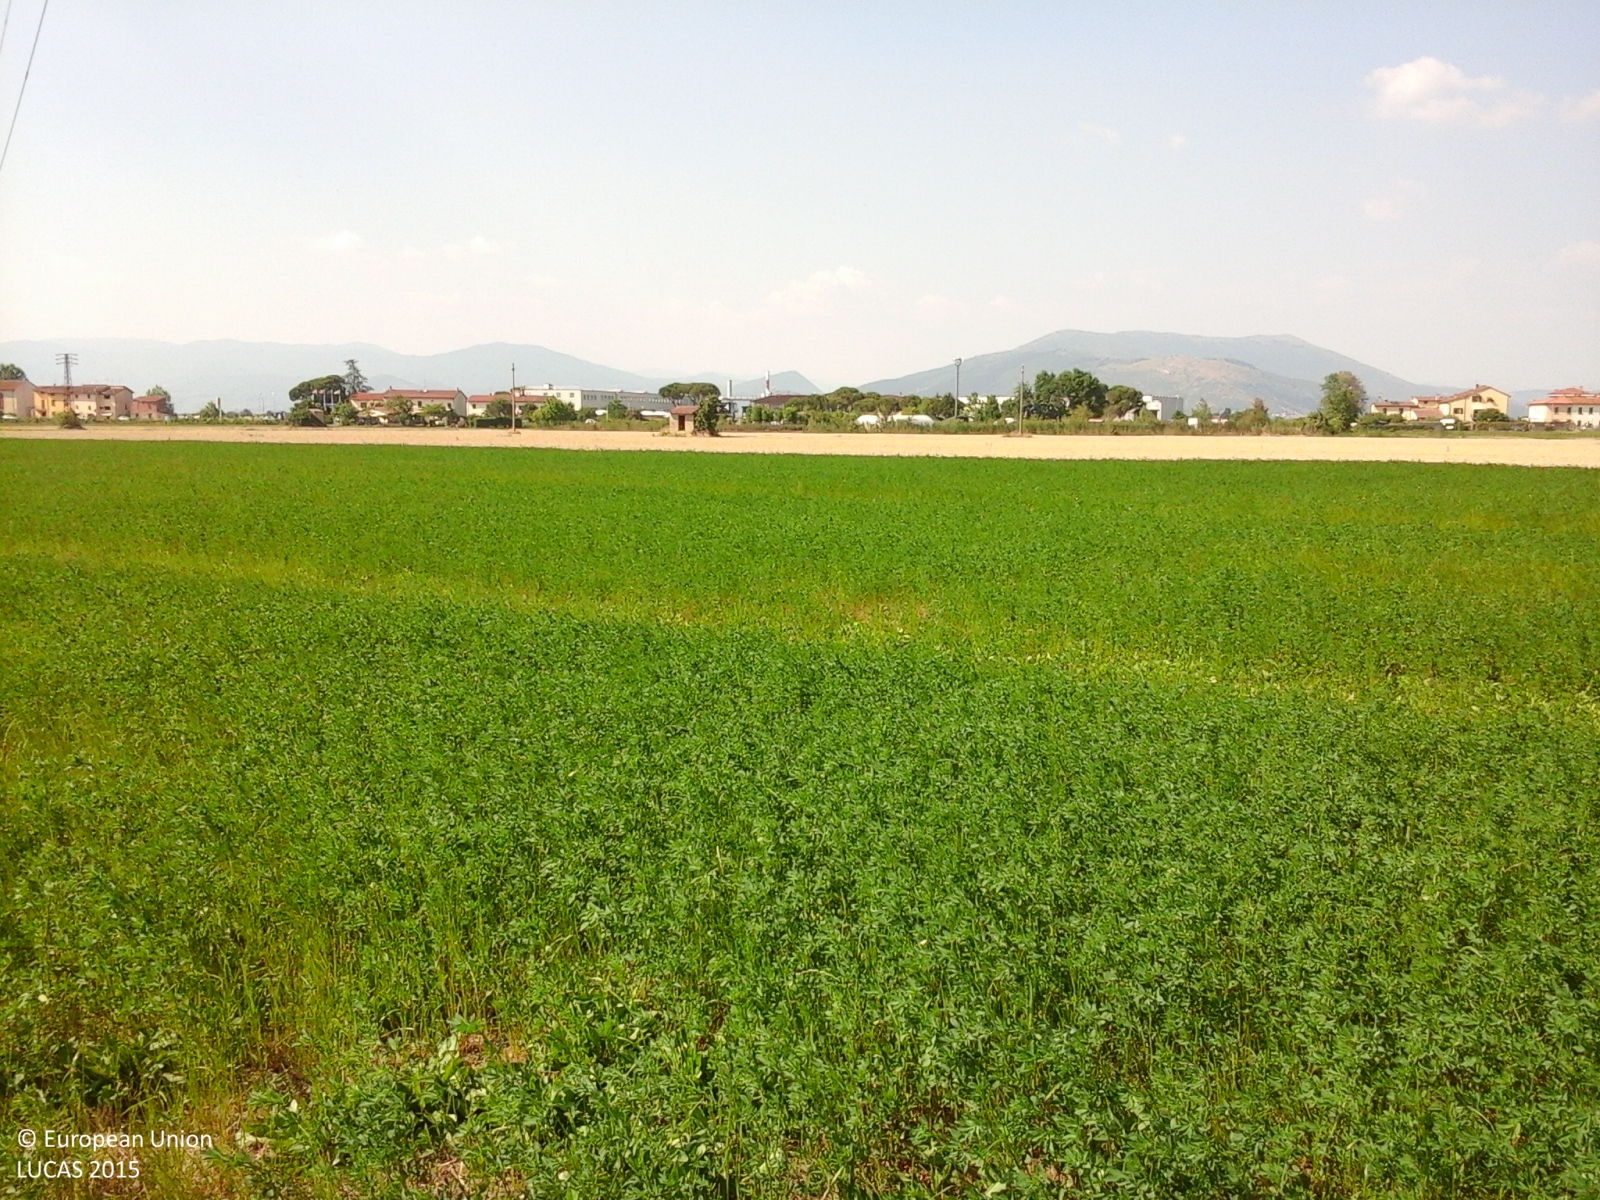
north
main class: Cropland
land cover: Lucerne
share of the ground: > 75 %
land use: Agriculture (excluding fallow land and kitchen gardens)
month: June
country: IT
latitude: 43.8034
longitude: 11.1034
